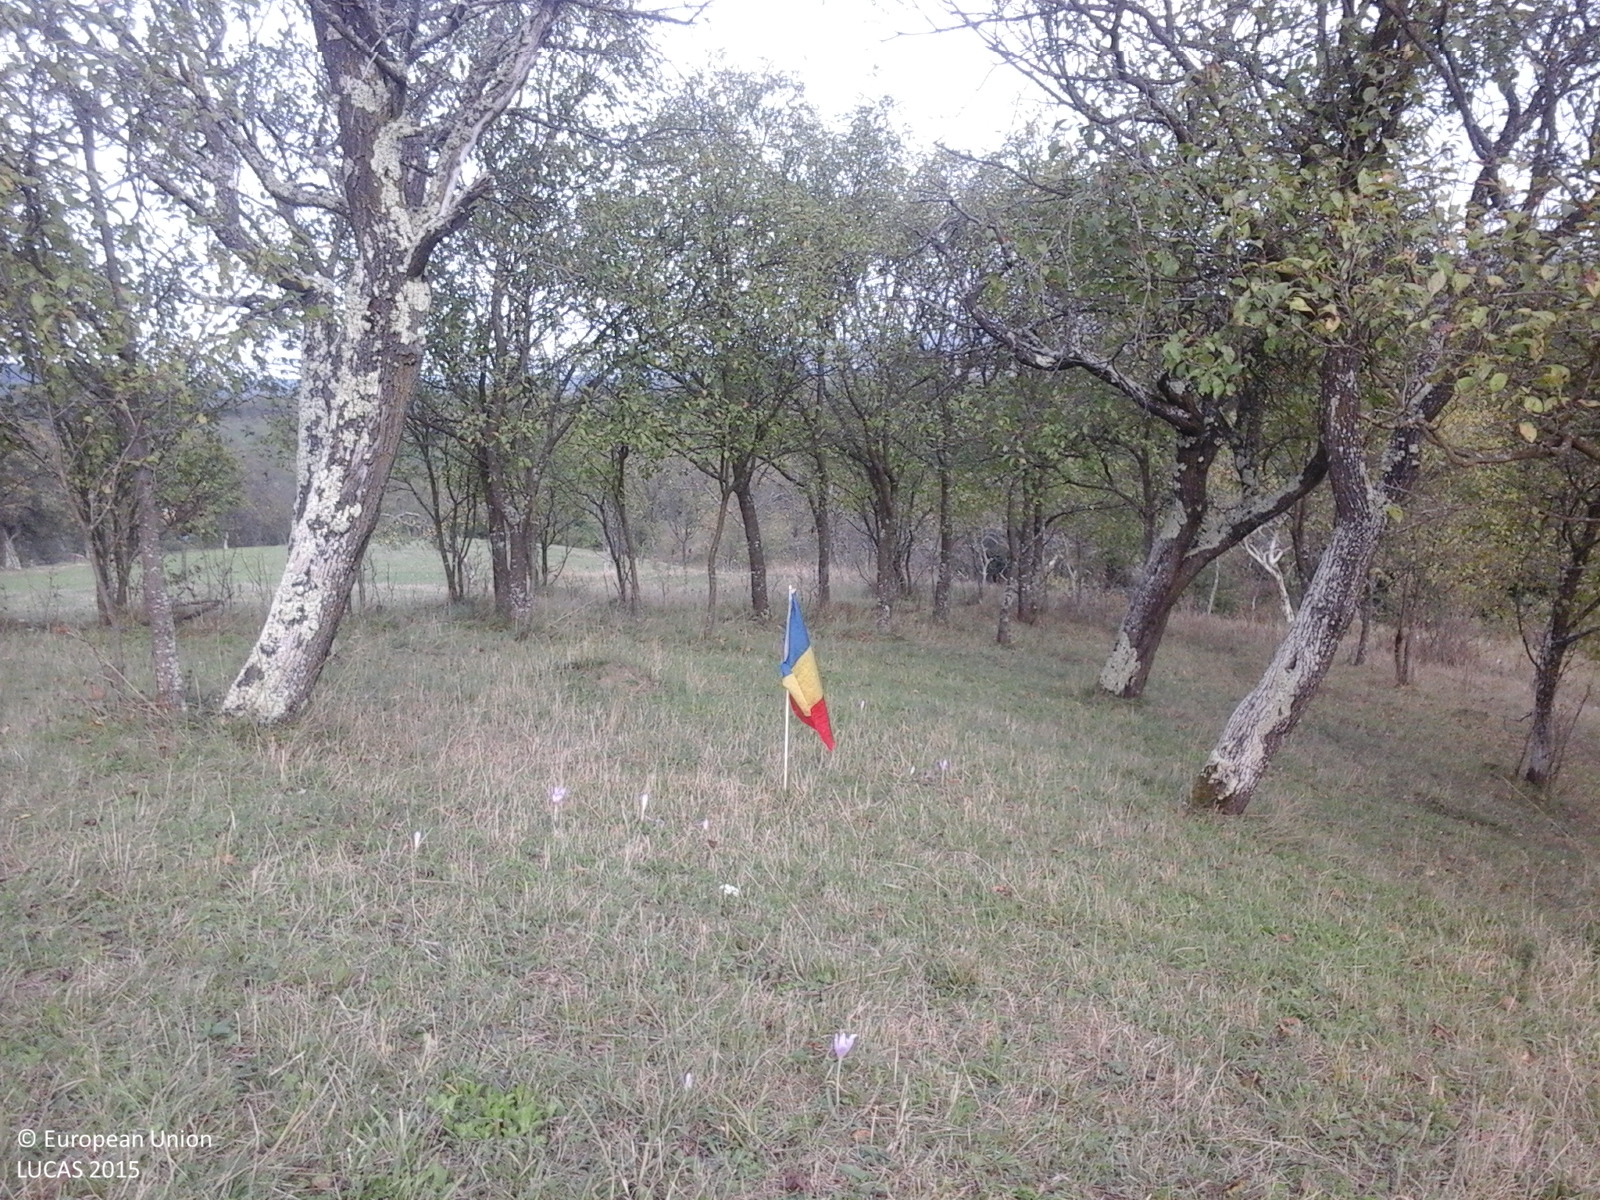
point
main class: Cropland
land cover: Other fruit trees and berries
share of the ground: 50 - 75 %
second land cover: Grassland without tree/shrub cover
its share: > 75 %
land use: Agriculture (excluding fallow land and kitchen gardens)
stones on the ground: < 10 %
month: September
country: RO
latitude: 47.0600
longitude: 23.0582
